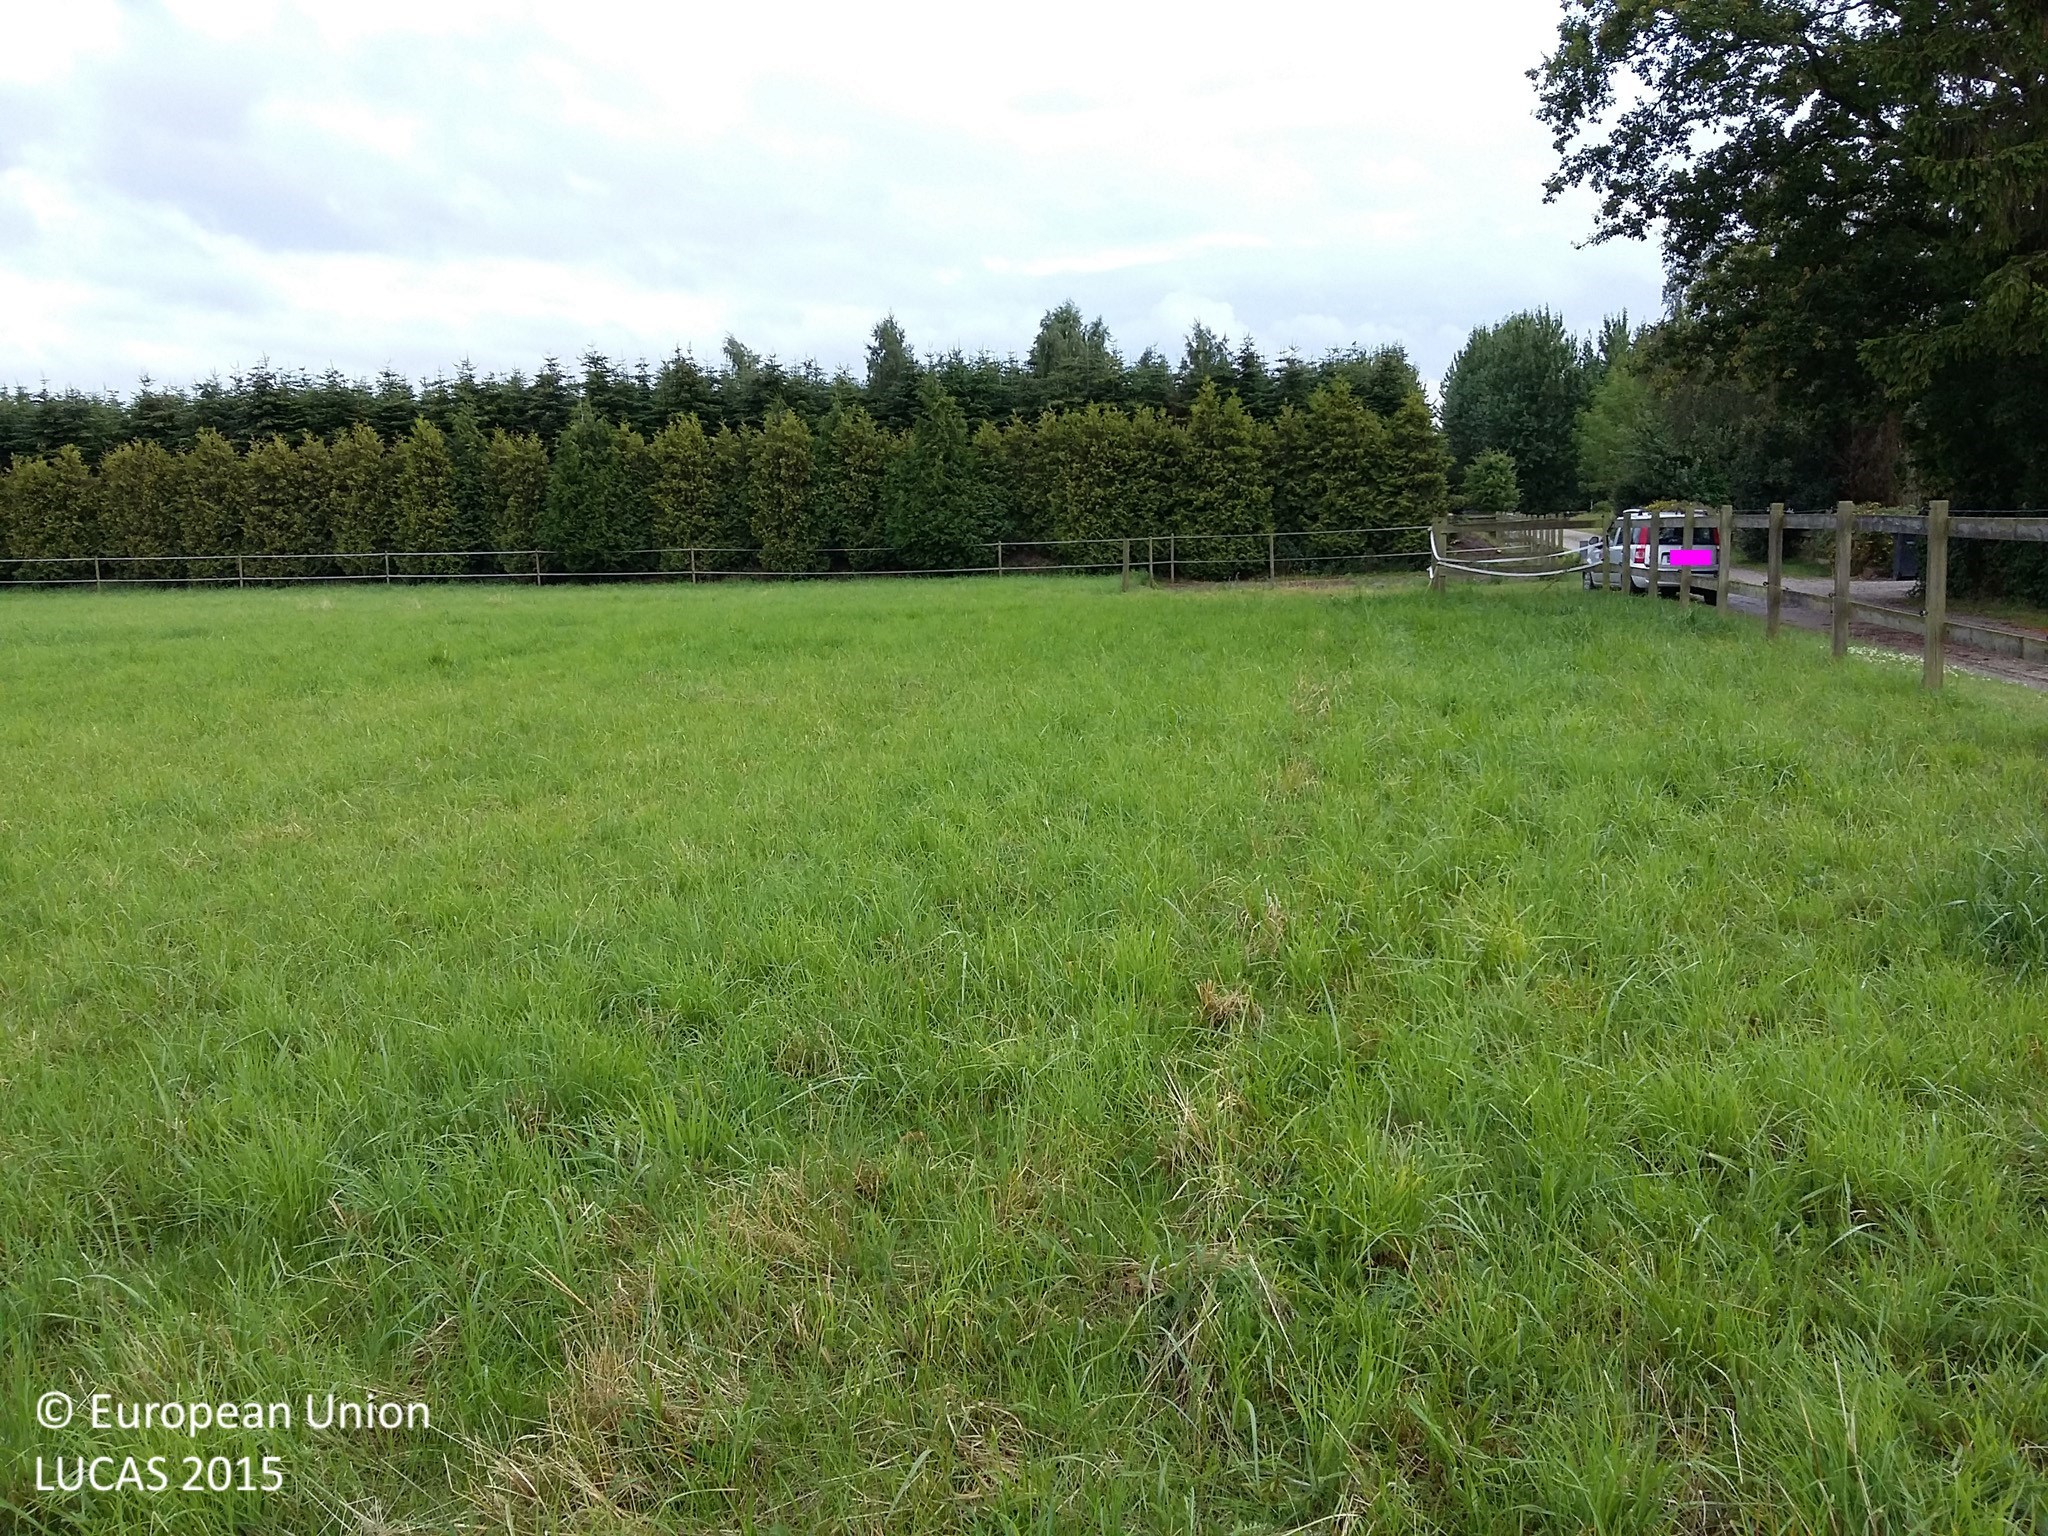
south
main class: Grassland
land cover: Grassland without tree/shrub cover
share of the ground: > 75 %
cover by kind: herbaceous plants 100 %
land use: Agriculture (excluding fallow land and kitchen gardens)
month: July
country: DK
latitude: 55.8280
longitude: 12.1532
